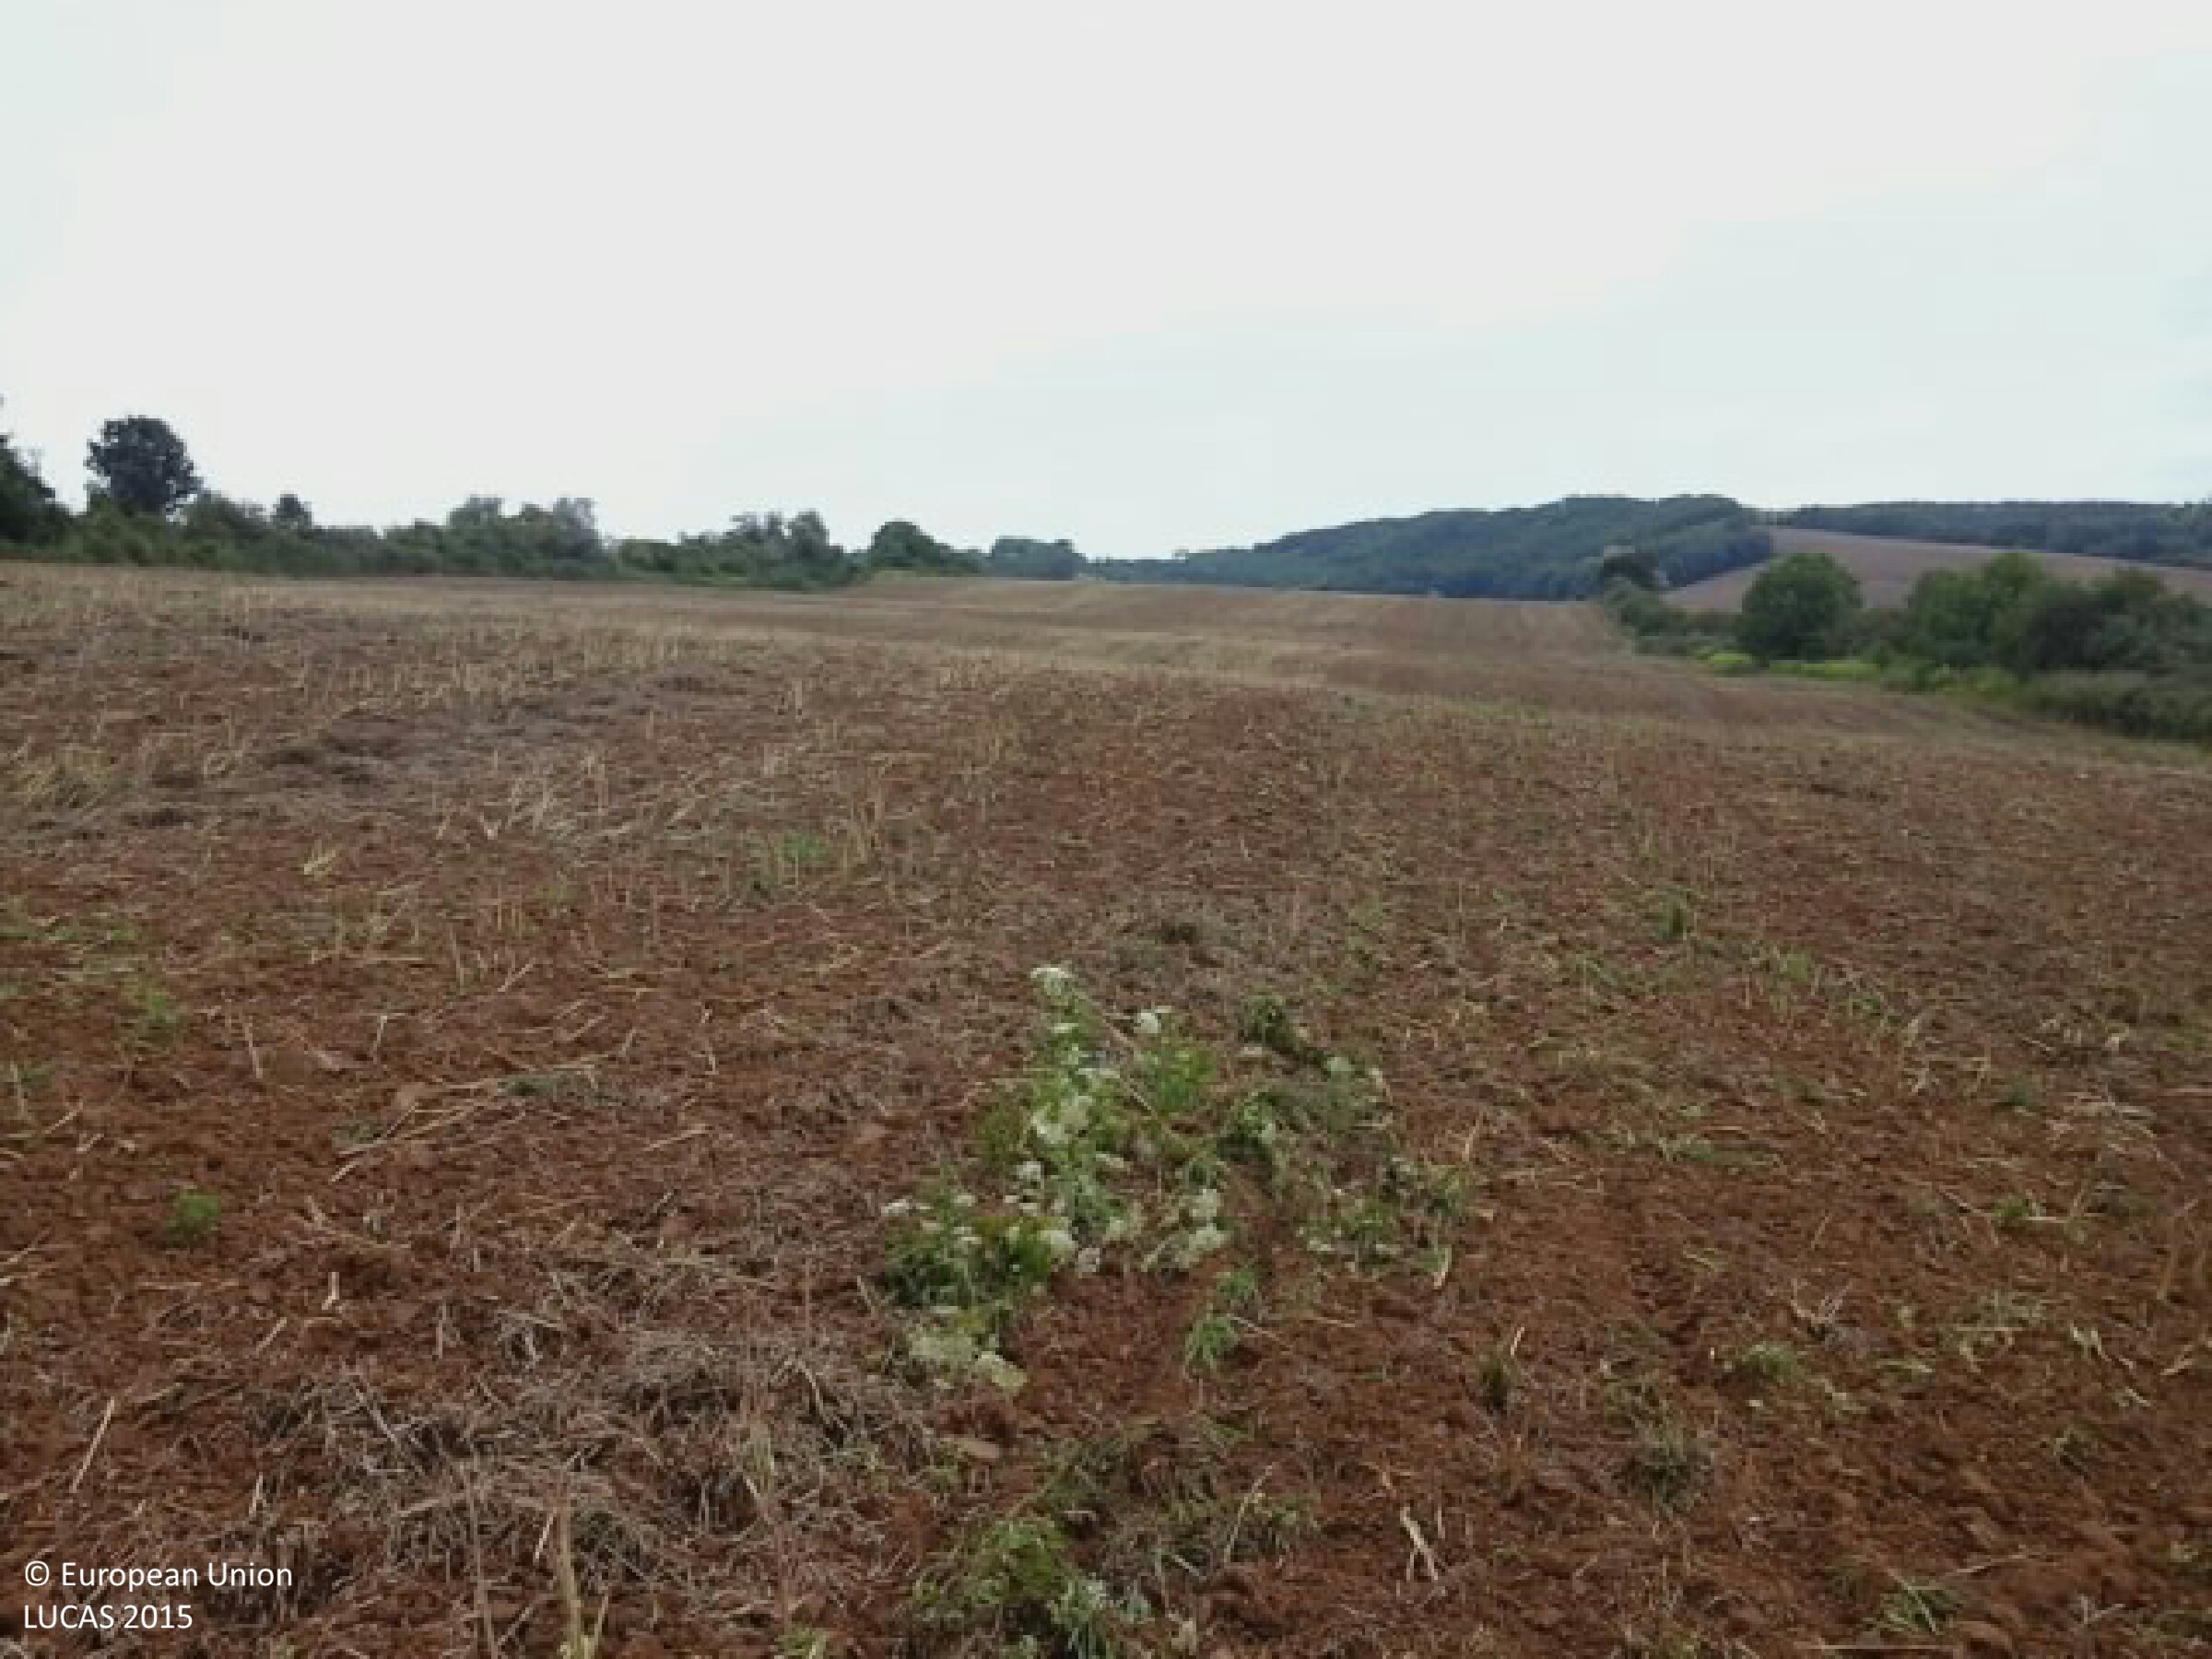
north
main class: Cropland
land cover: Rape and turnip rape
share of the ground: > 75 %
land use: Agriculture (excluding fallow land and kitchen gardens)
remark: Harvested field
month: July
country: HU
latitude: 46.2534
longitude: 17.9580
